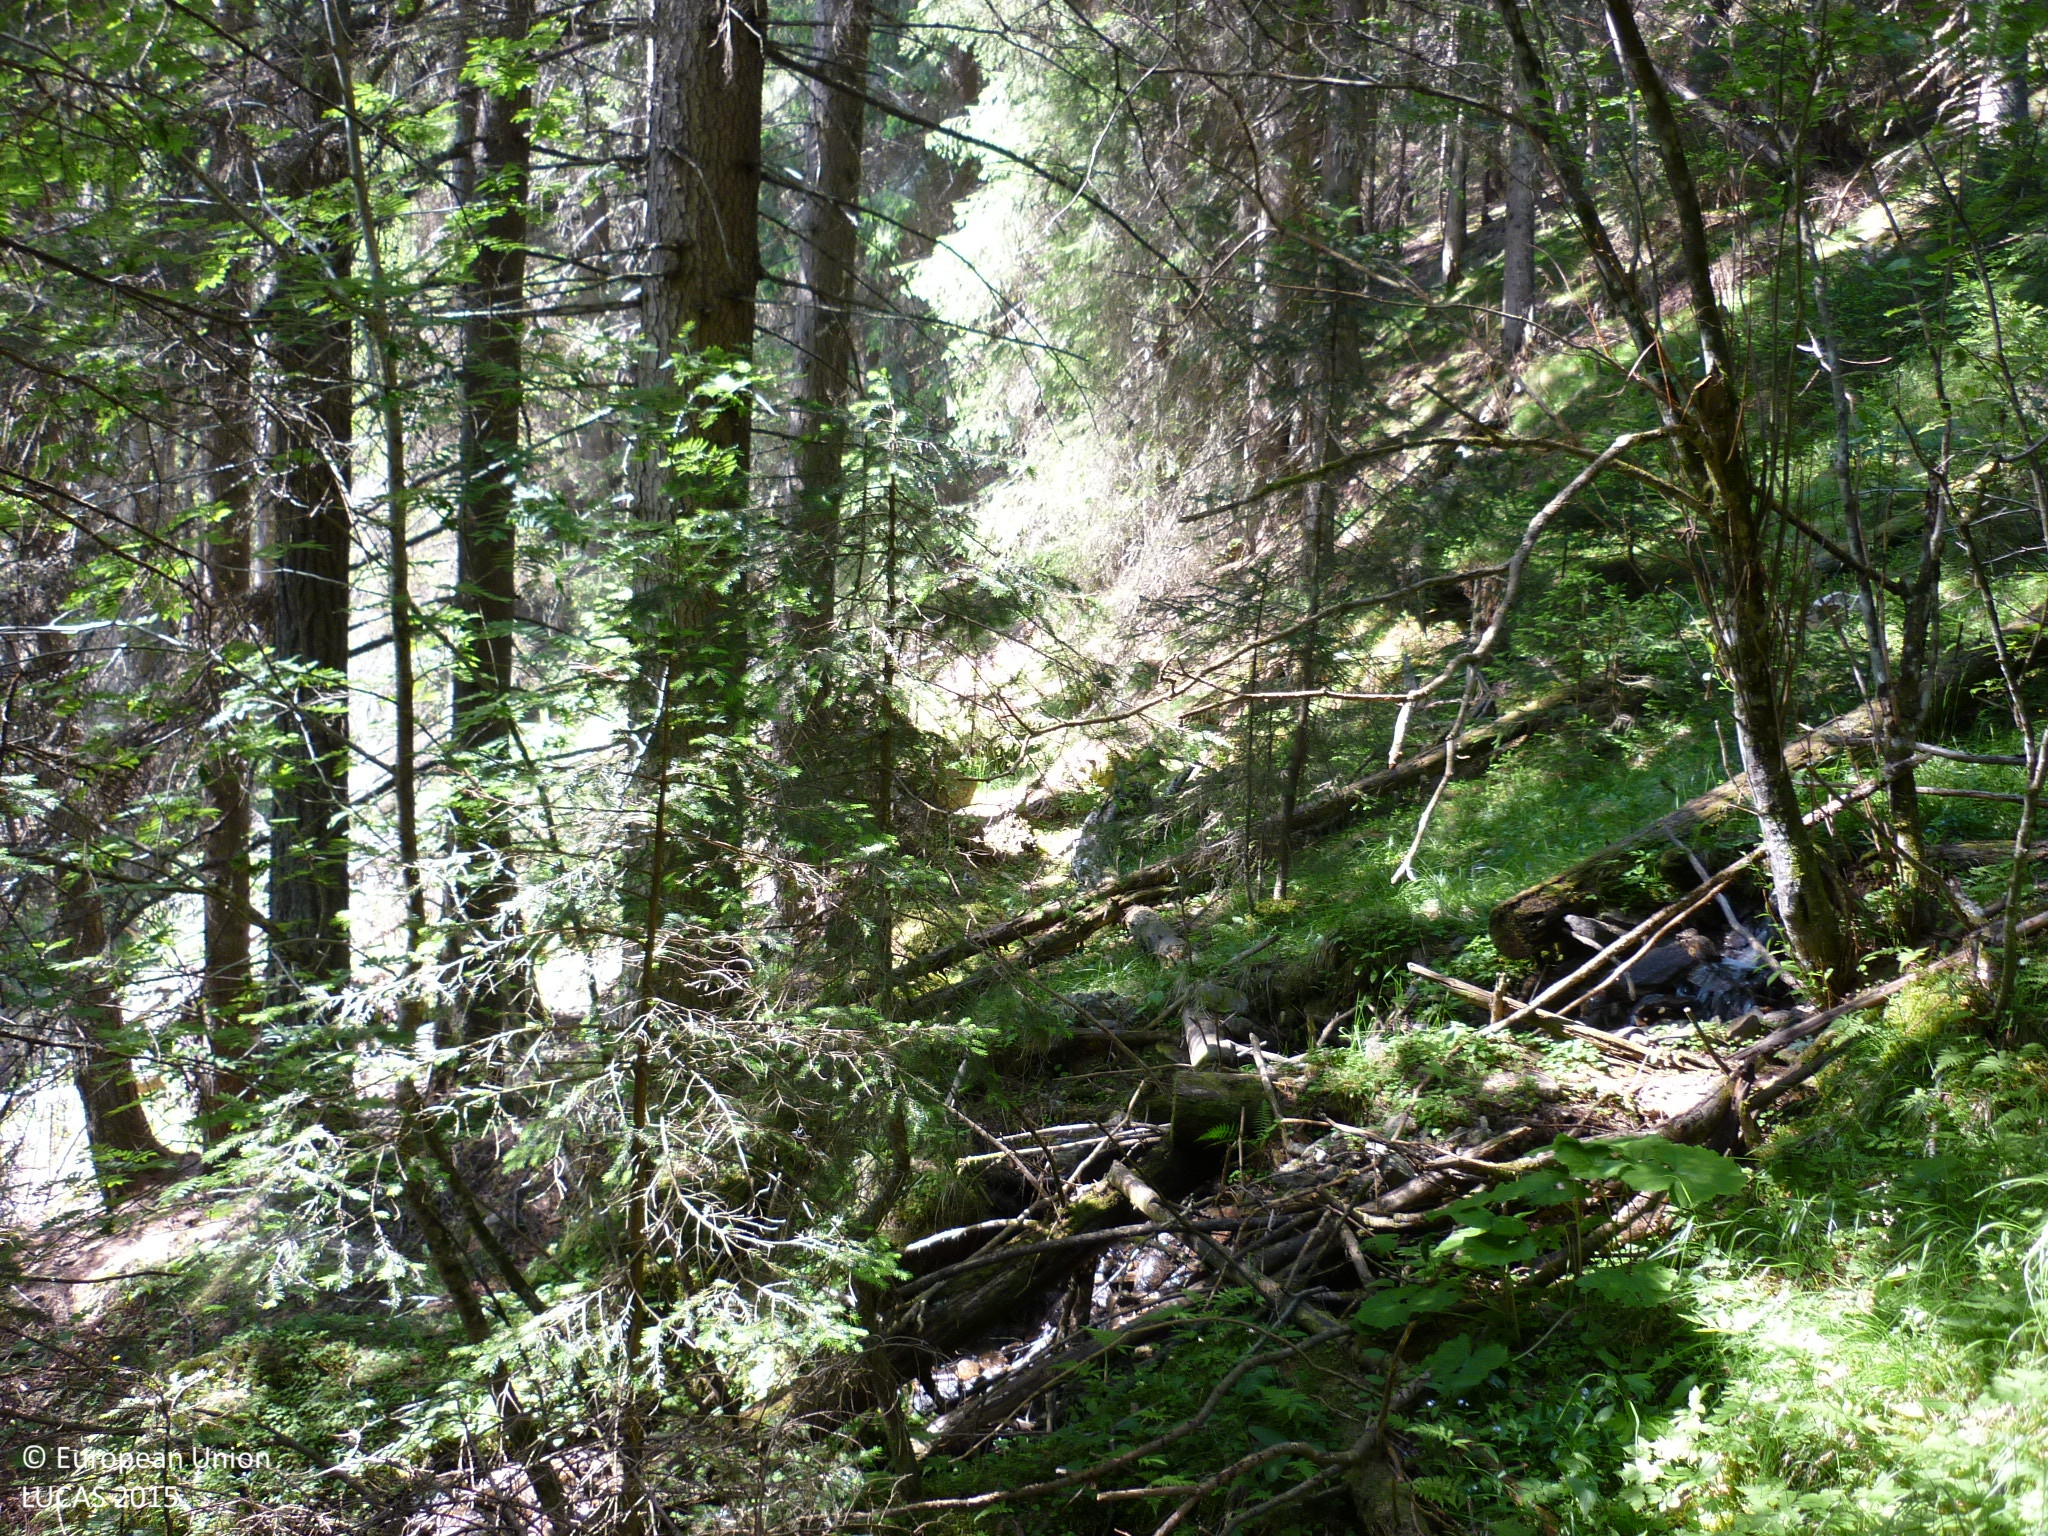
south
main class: Woodland
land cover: Spruce dominated coniferous woodland
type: alpine coniferous forest
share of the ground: > 75 %
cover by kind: coniferous forest trees 85 %, herbaceous plants 10 %, broadleaved forest trees 5 %
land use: Forestry
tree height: > 5 m
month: July
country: AT
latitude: 47.0810
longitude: 14.6216
